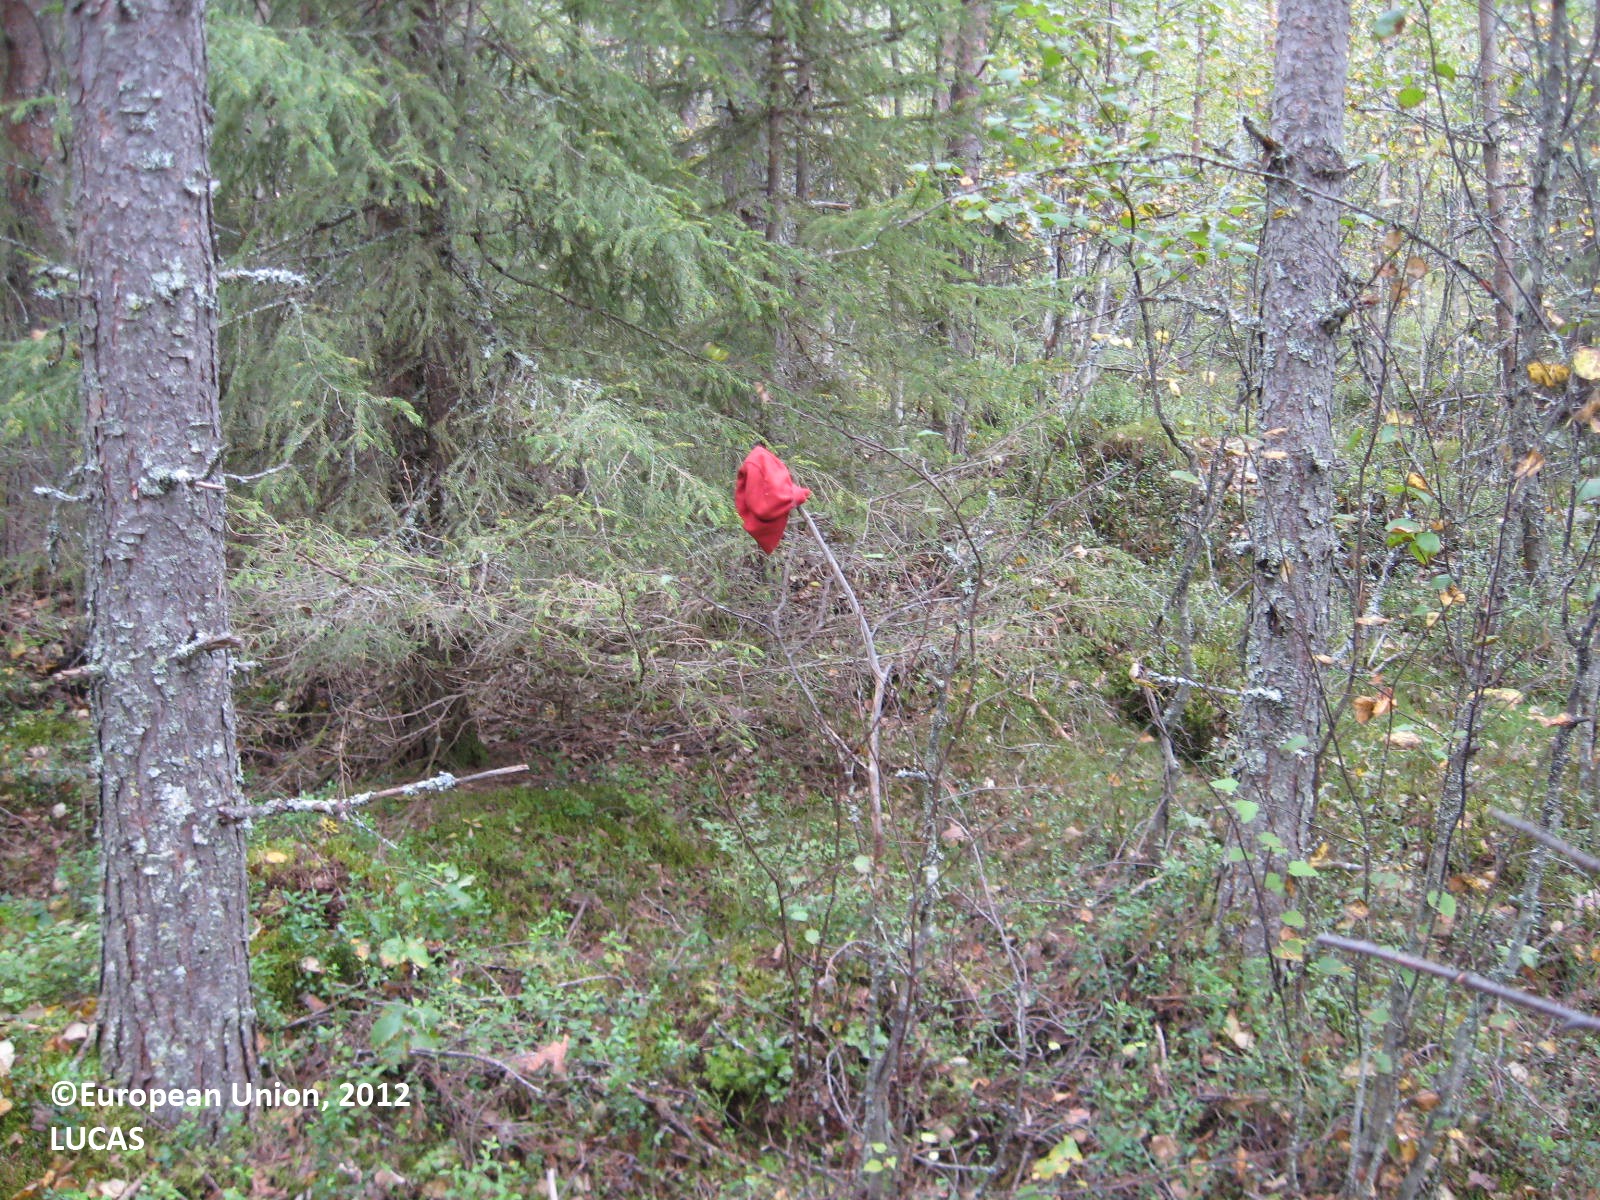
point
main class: Woodland
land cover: Pine dominated mixed woodland
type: boreal forest
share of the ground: > 75 %
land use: Forestry
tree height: > 5 m
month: August
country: FI
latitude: 63.5467
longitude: 30.3215
